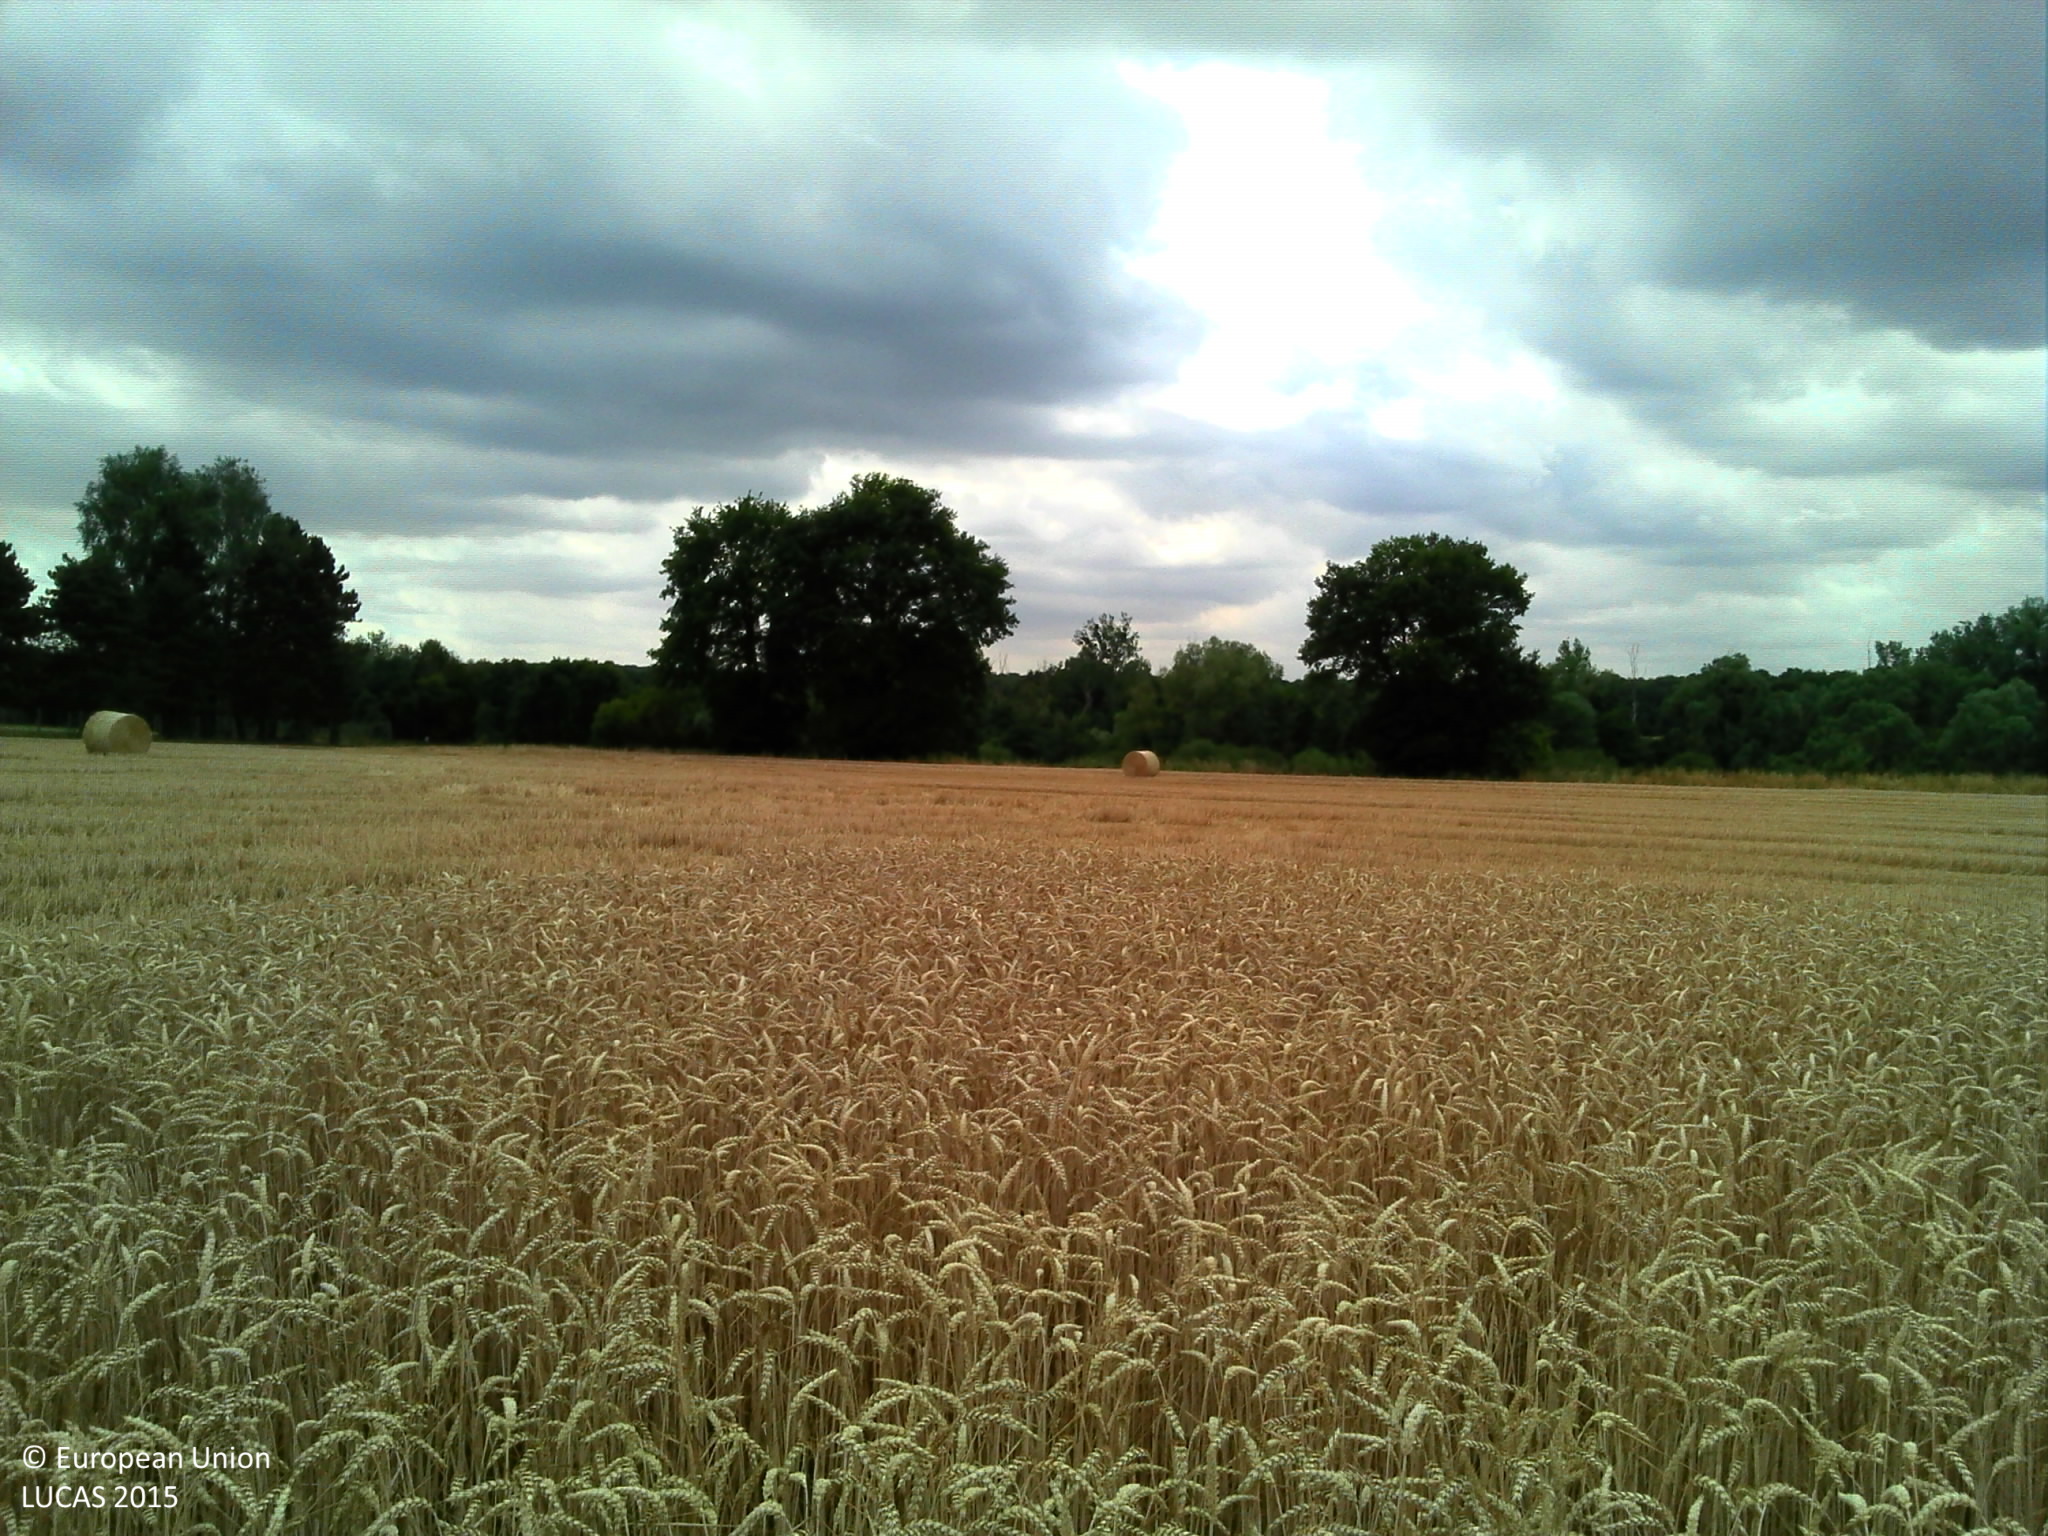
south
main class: Cropland
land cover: Common wheat
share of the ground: > 75 %
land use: Agriculture (excluding fallow land and kitchen gardens)
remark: Harvested field
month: July
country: FR
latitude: 49.1883
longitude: 2.6485
